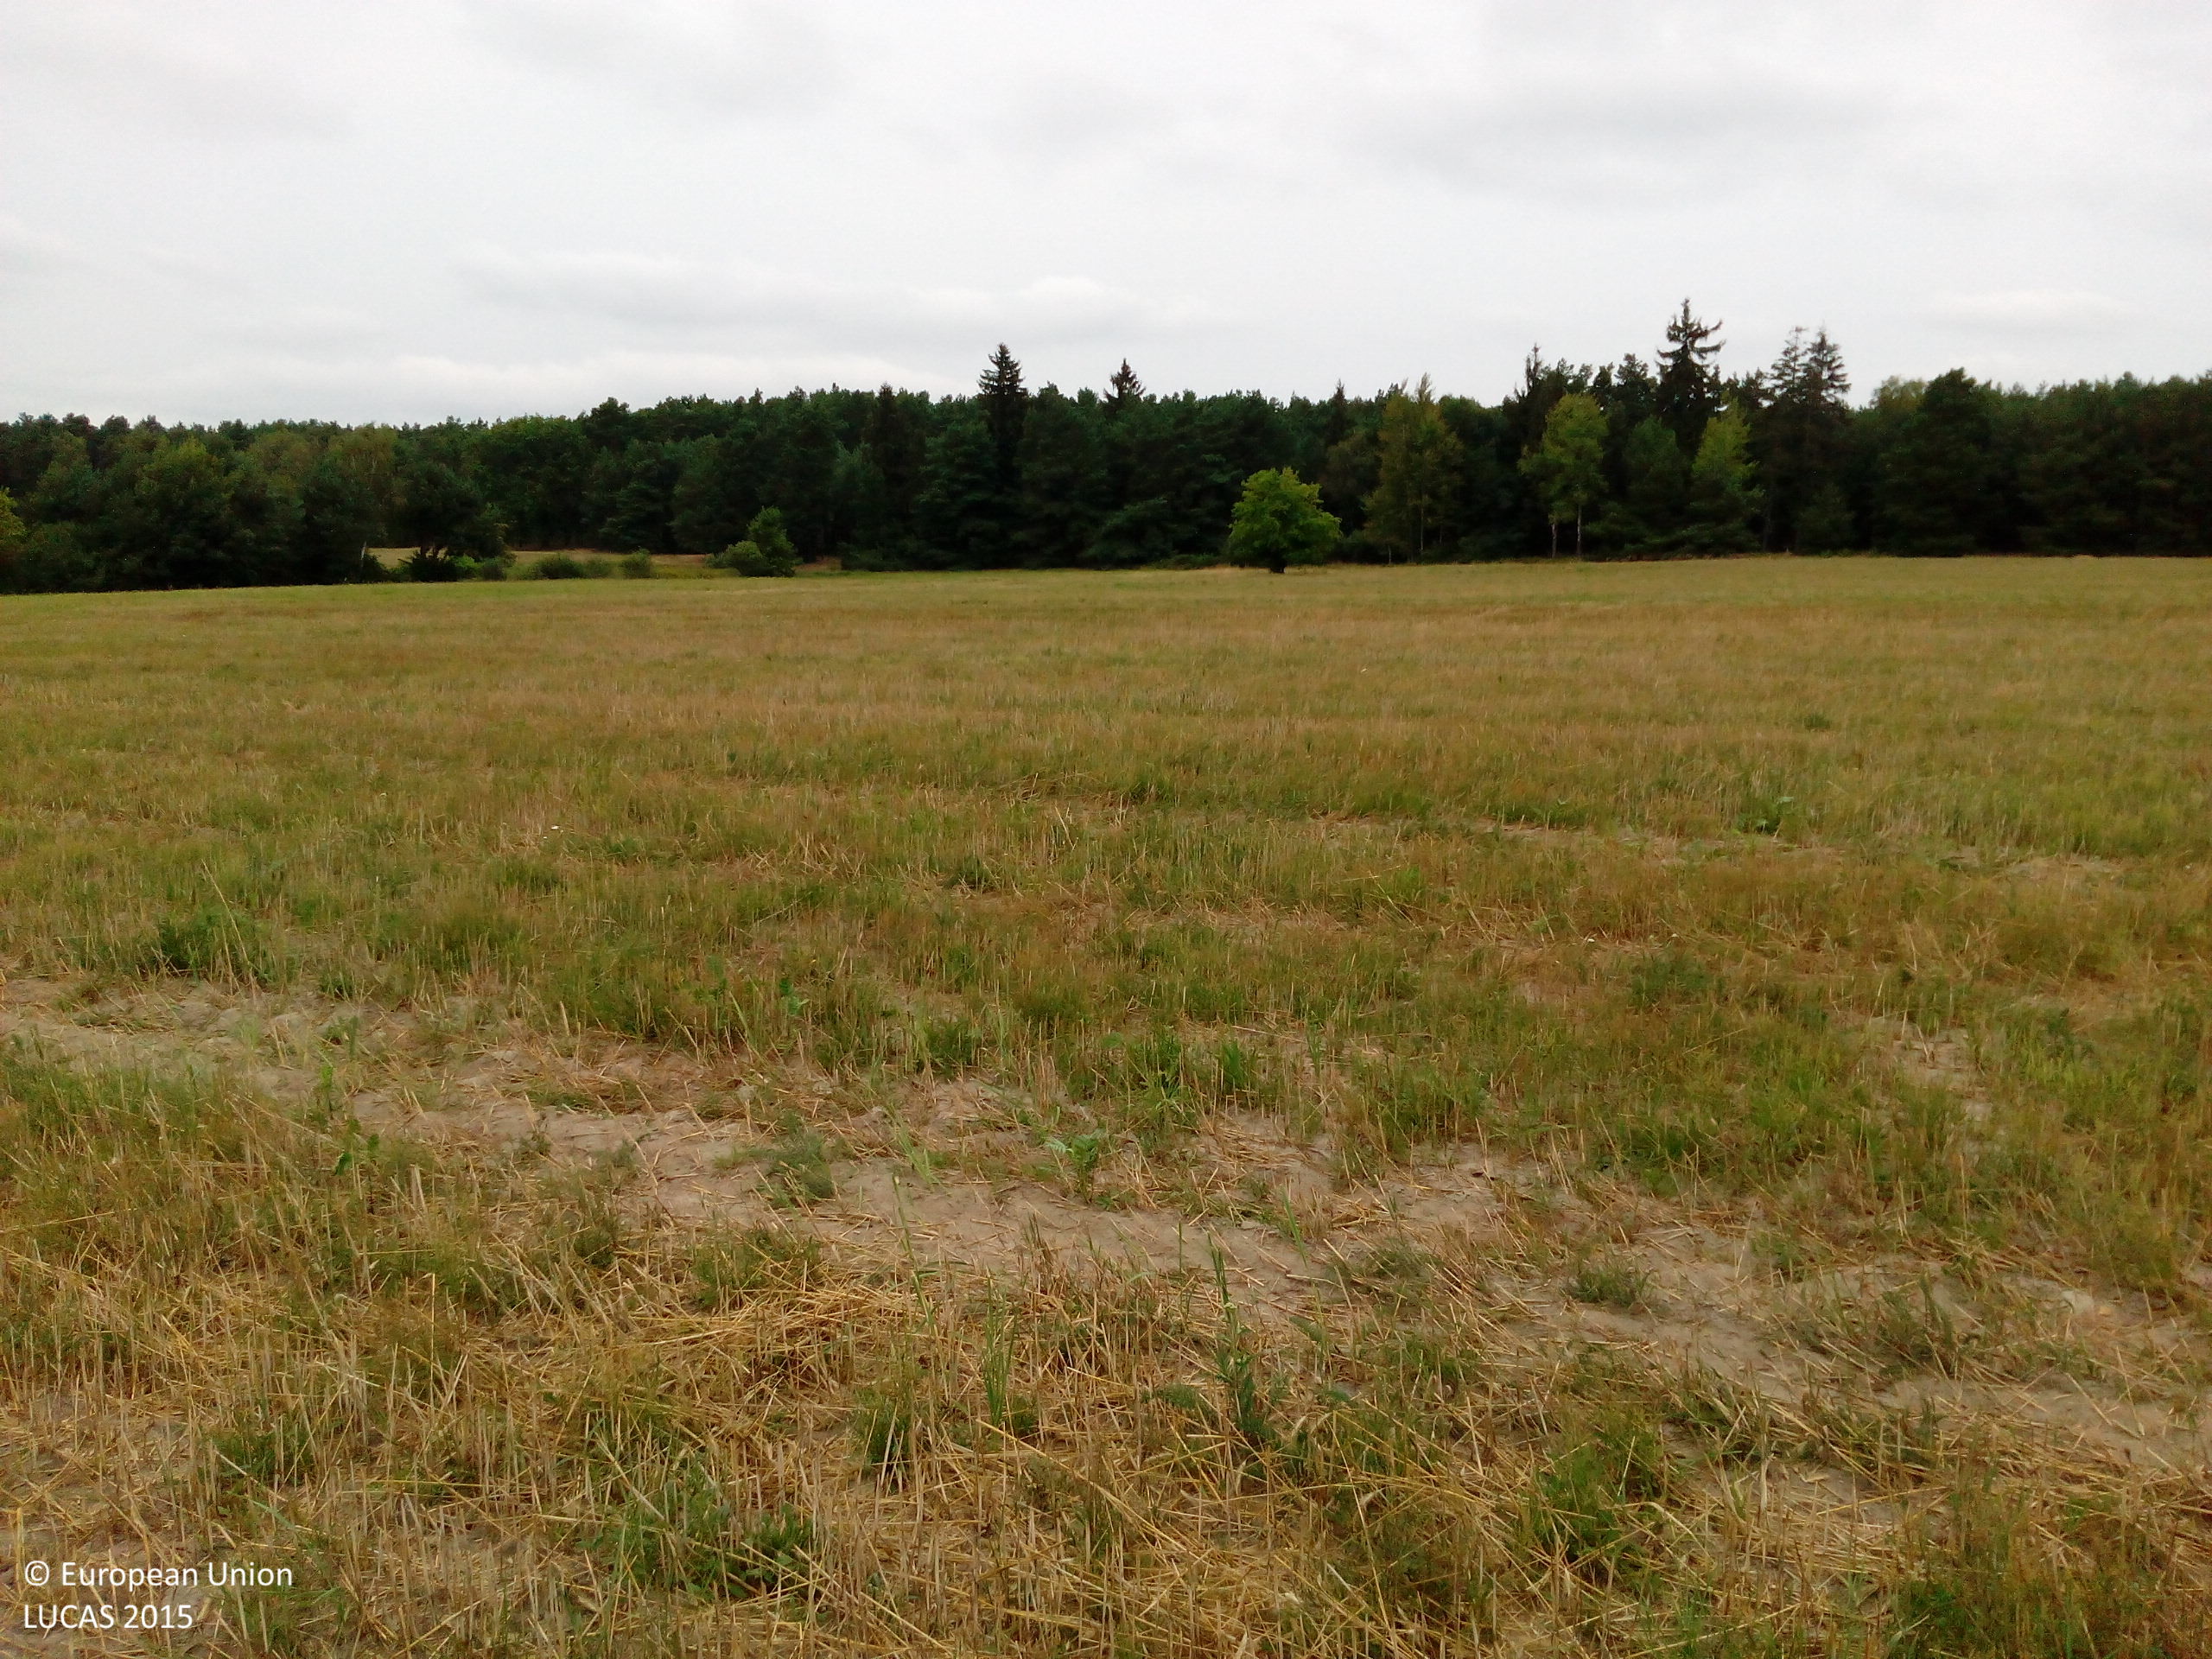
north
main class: Cropland
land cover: Rye
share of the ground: < 10 %
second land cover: Spontaneously vegetated surfaces
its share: 25 - 50 %
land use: Agriculture (excluding fallow land and kitchen gardens)
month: August
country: DE
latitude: 51.9451
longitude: 14.1473
